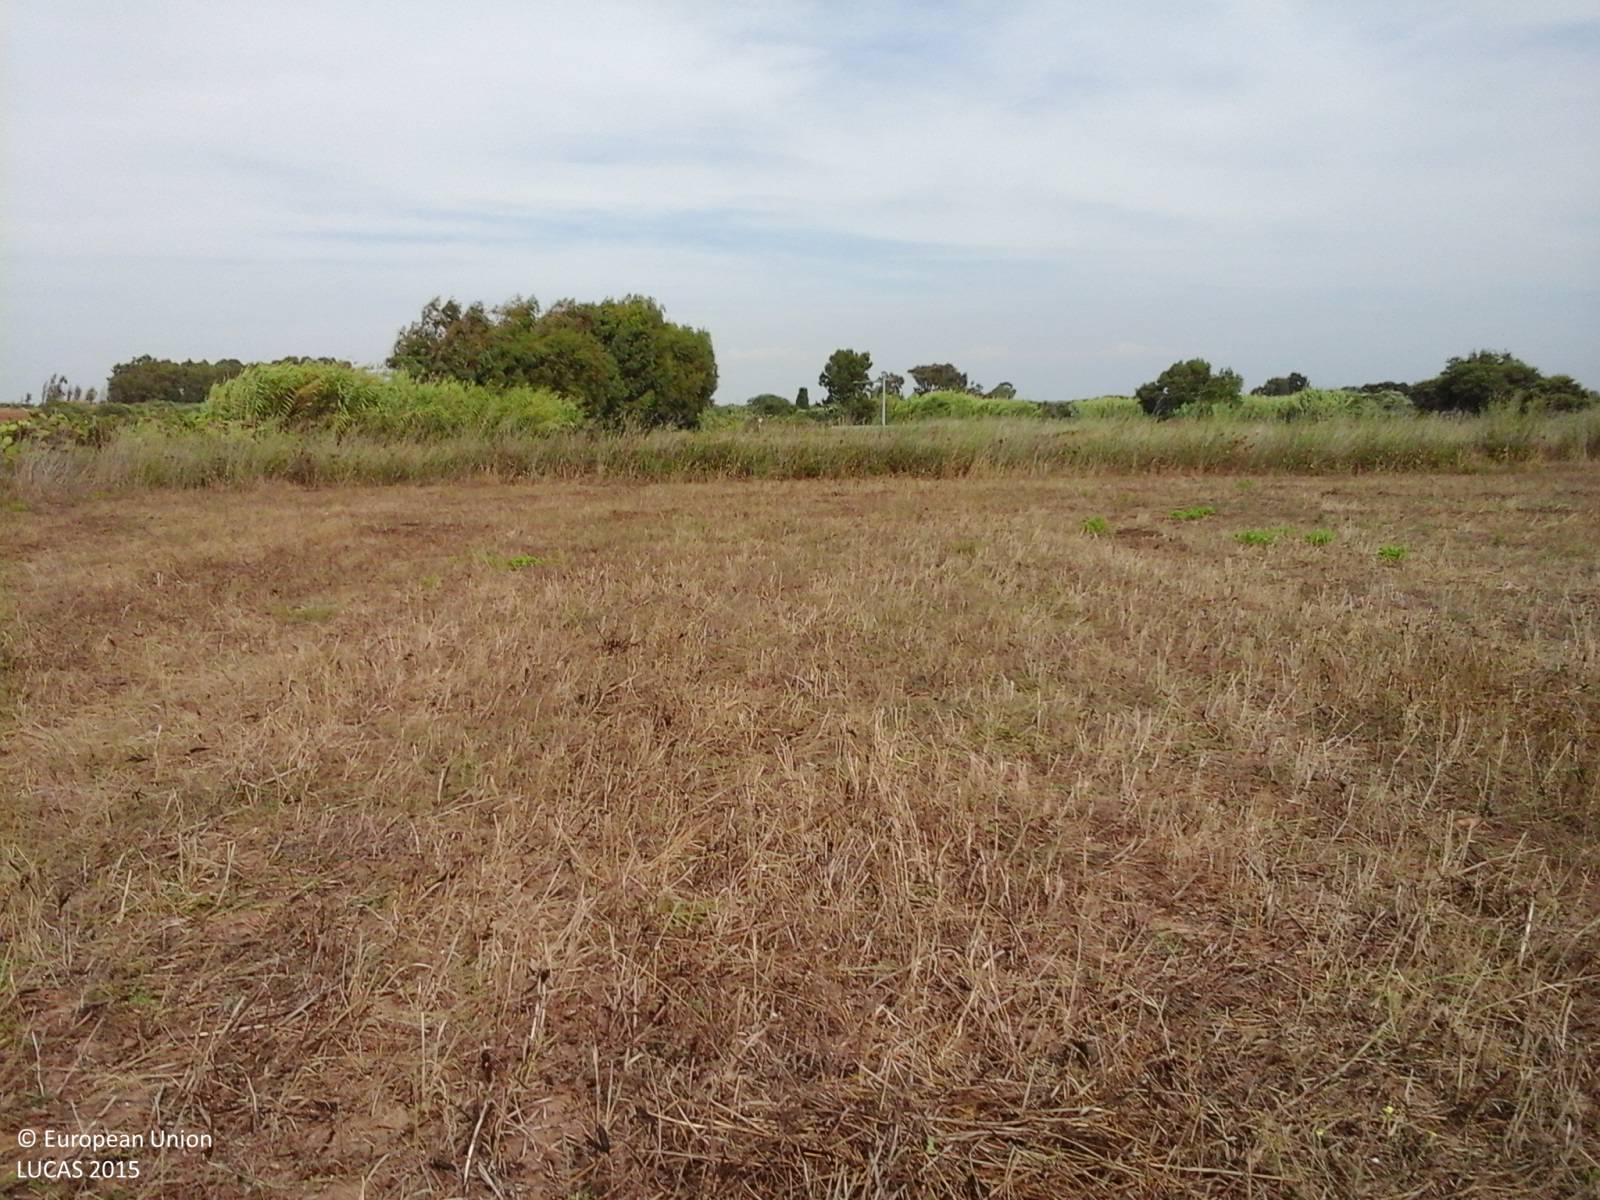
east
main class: Cropland
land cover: Temporary grasslands
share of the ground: > 75 %
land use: Agriculture (excluding fallow land and kitchen gardens)
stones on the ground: < 10 %
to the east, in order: Temporary grasslands; Abandoned hedges; Durum wheat; Grass margins; Paved roads, cycling and walking lanes; Grassland with sparse tree/shrub cover; Tracks; Grassland without tree/shrub cover
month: August
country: IT
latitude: 40.0208
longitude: 8.5200
